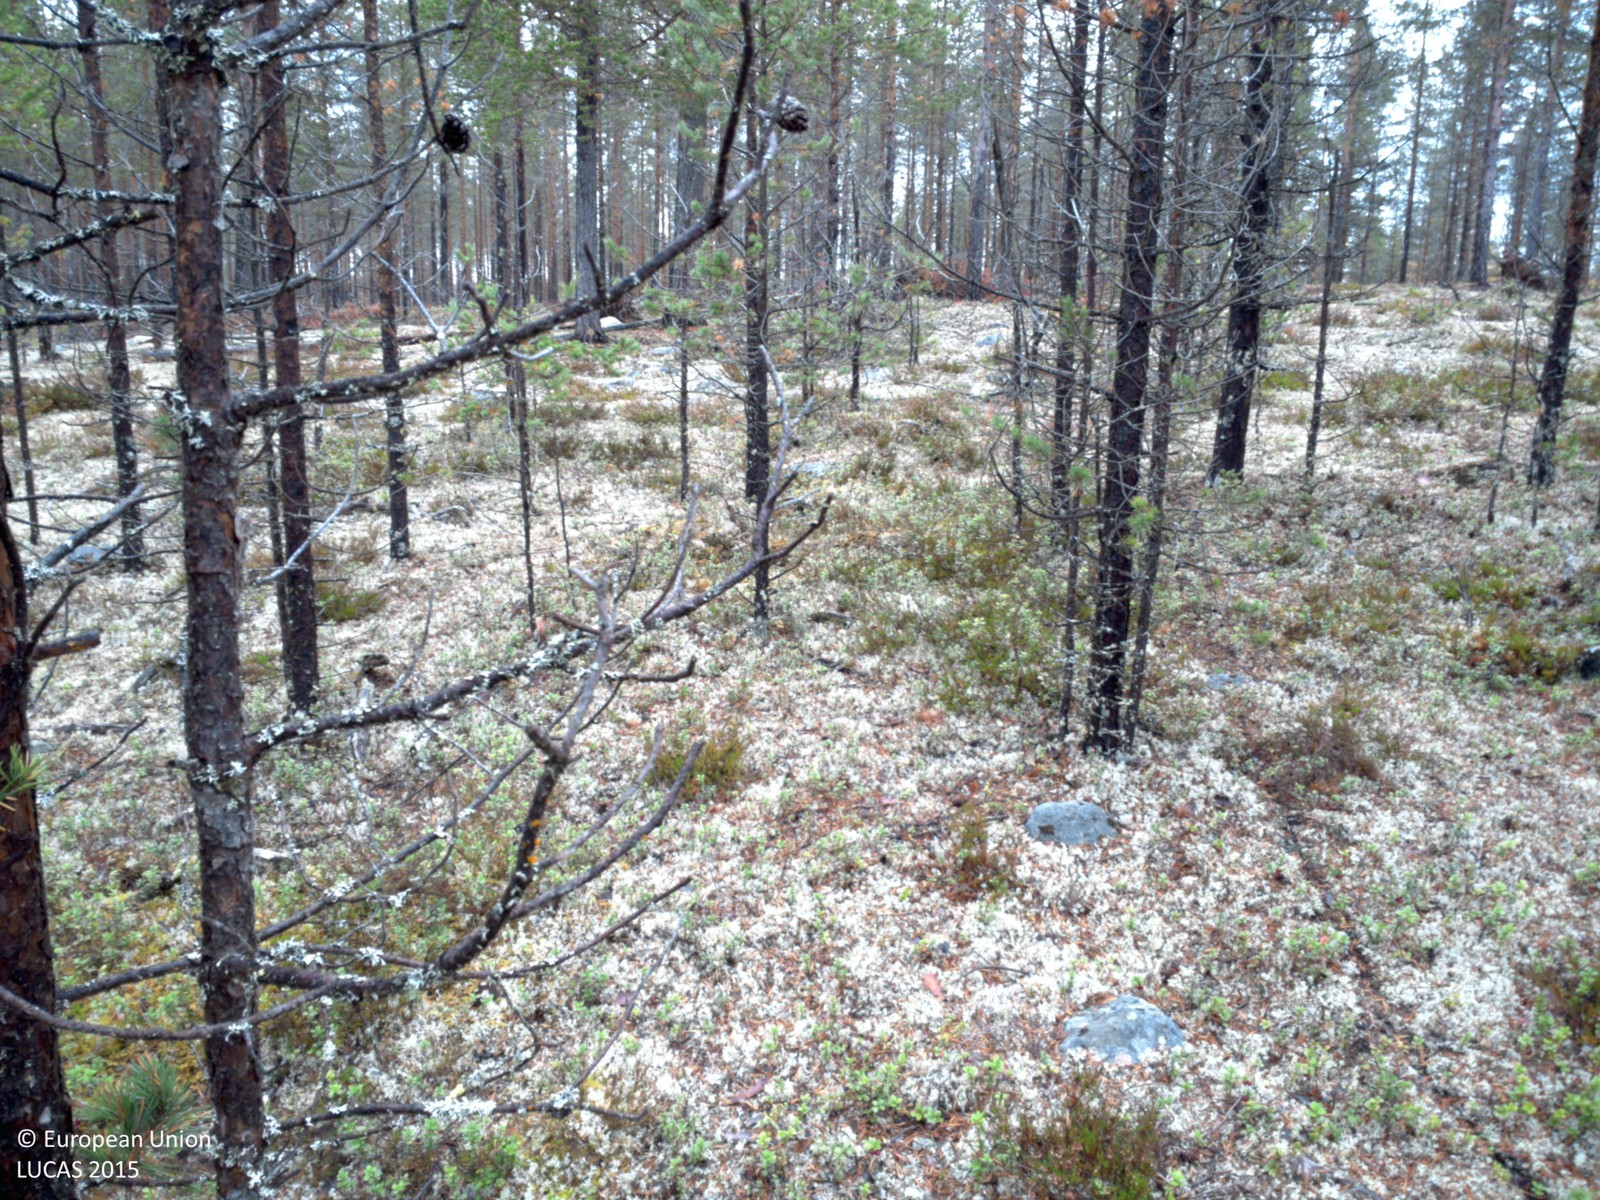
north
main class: Woodland
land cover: Pine dominated coniferous woodland
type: boreal forest
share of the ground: > 75 %
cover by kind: coniferous forest trees 80 %, shrubs 10 %, lichens and mosses 10 %
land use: Forestry
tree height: > 5 m
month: September
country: SE
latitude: 64.7323
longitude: 19.1860
